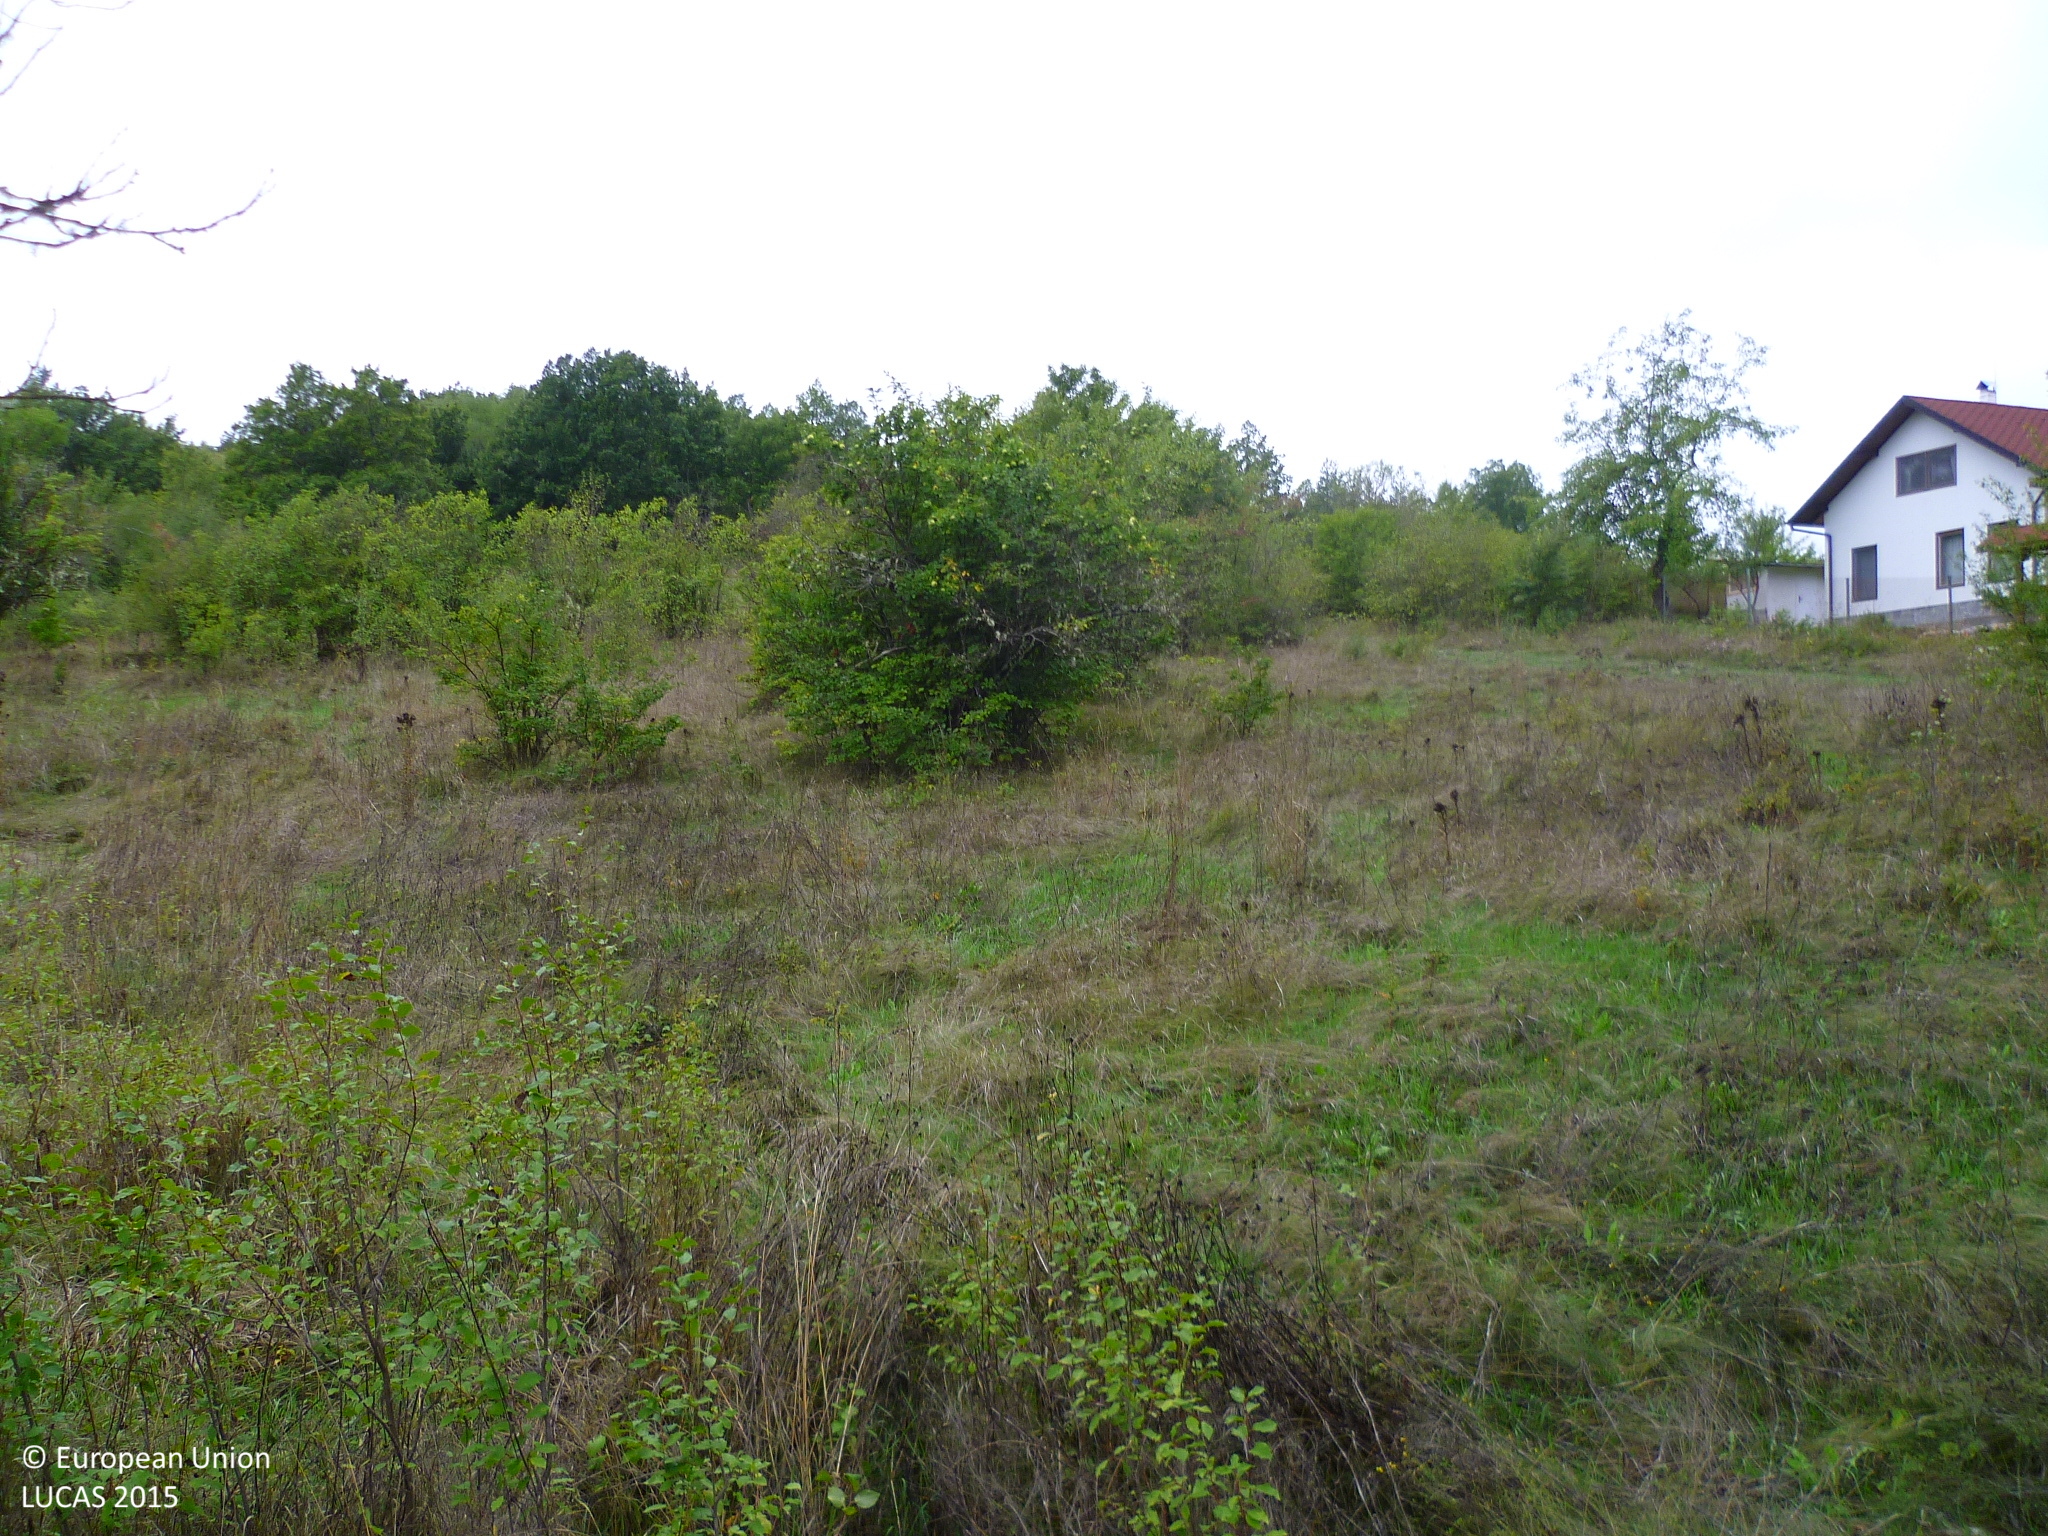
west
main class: Grassland
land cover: Grassland with sparse tree/shrub cover
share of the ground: > 75 %
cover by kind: herbaceous plants 90 %, broadleaved forest trees 5 %, shrubs 5 %
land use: Agriculture (excluding fallow land and kitchen gardens)
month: September
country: BG
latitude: 42.5833
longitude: 22.6844
